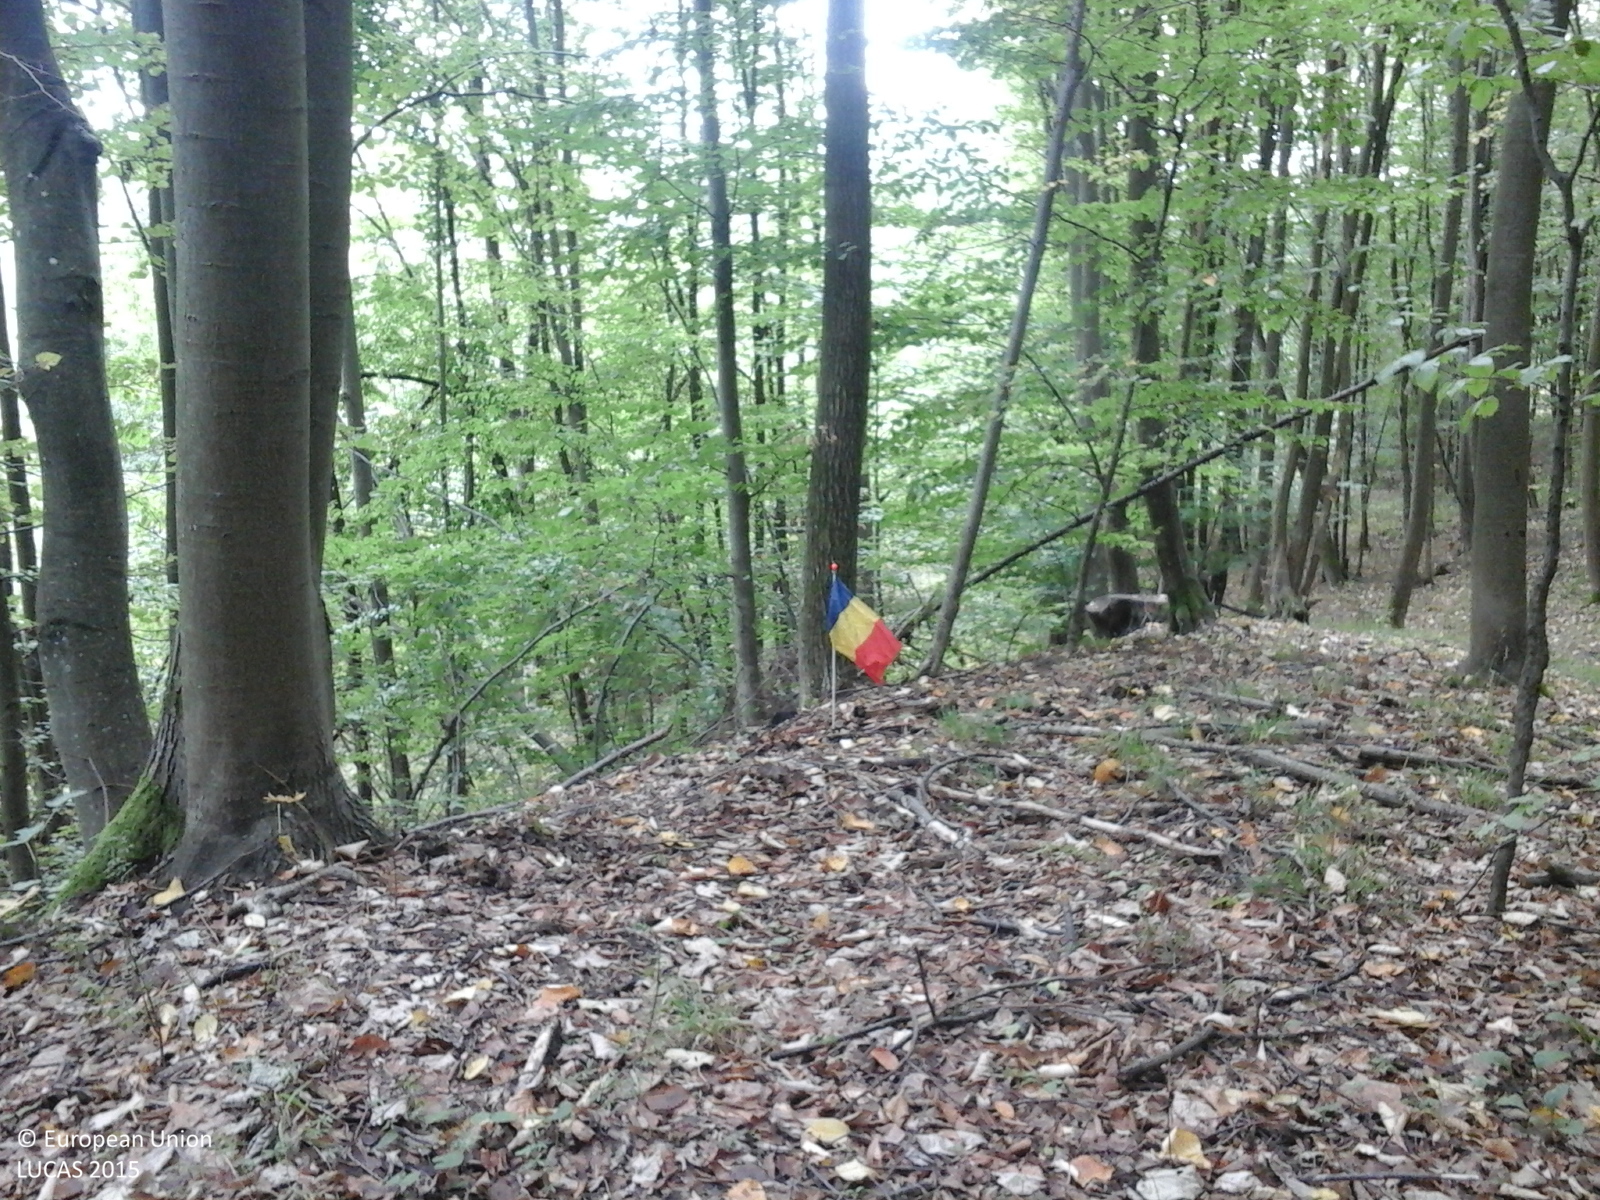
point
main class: Woodland
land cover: Broadleaved woodland
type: beech forest
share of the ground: > 75 %
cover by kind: broadleaved forest trees 100 %
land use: Forestry
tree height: > 5 m
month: September
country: RO
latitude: 45.9460
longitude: 21.9994
